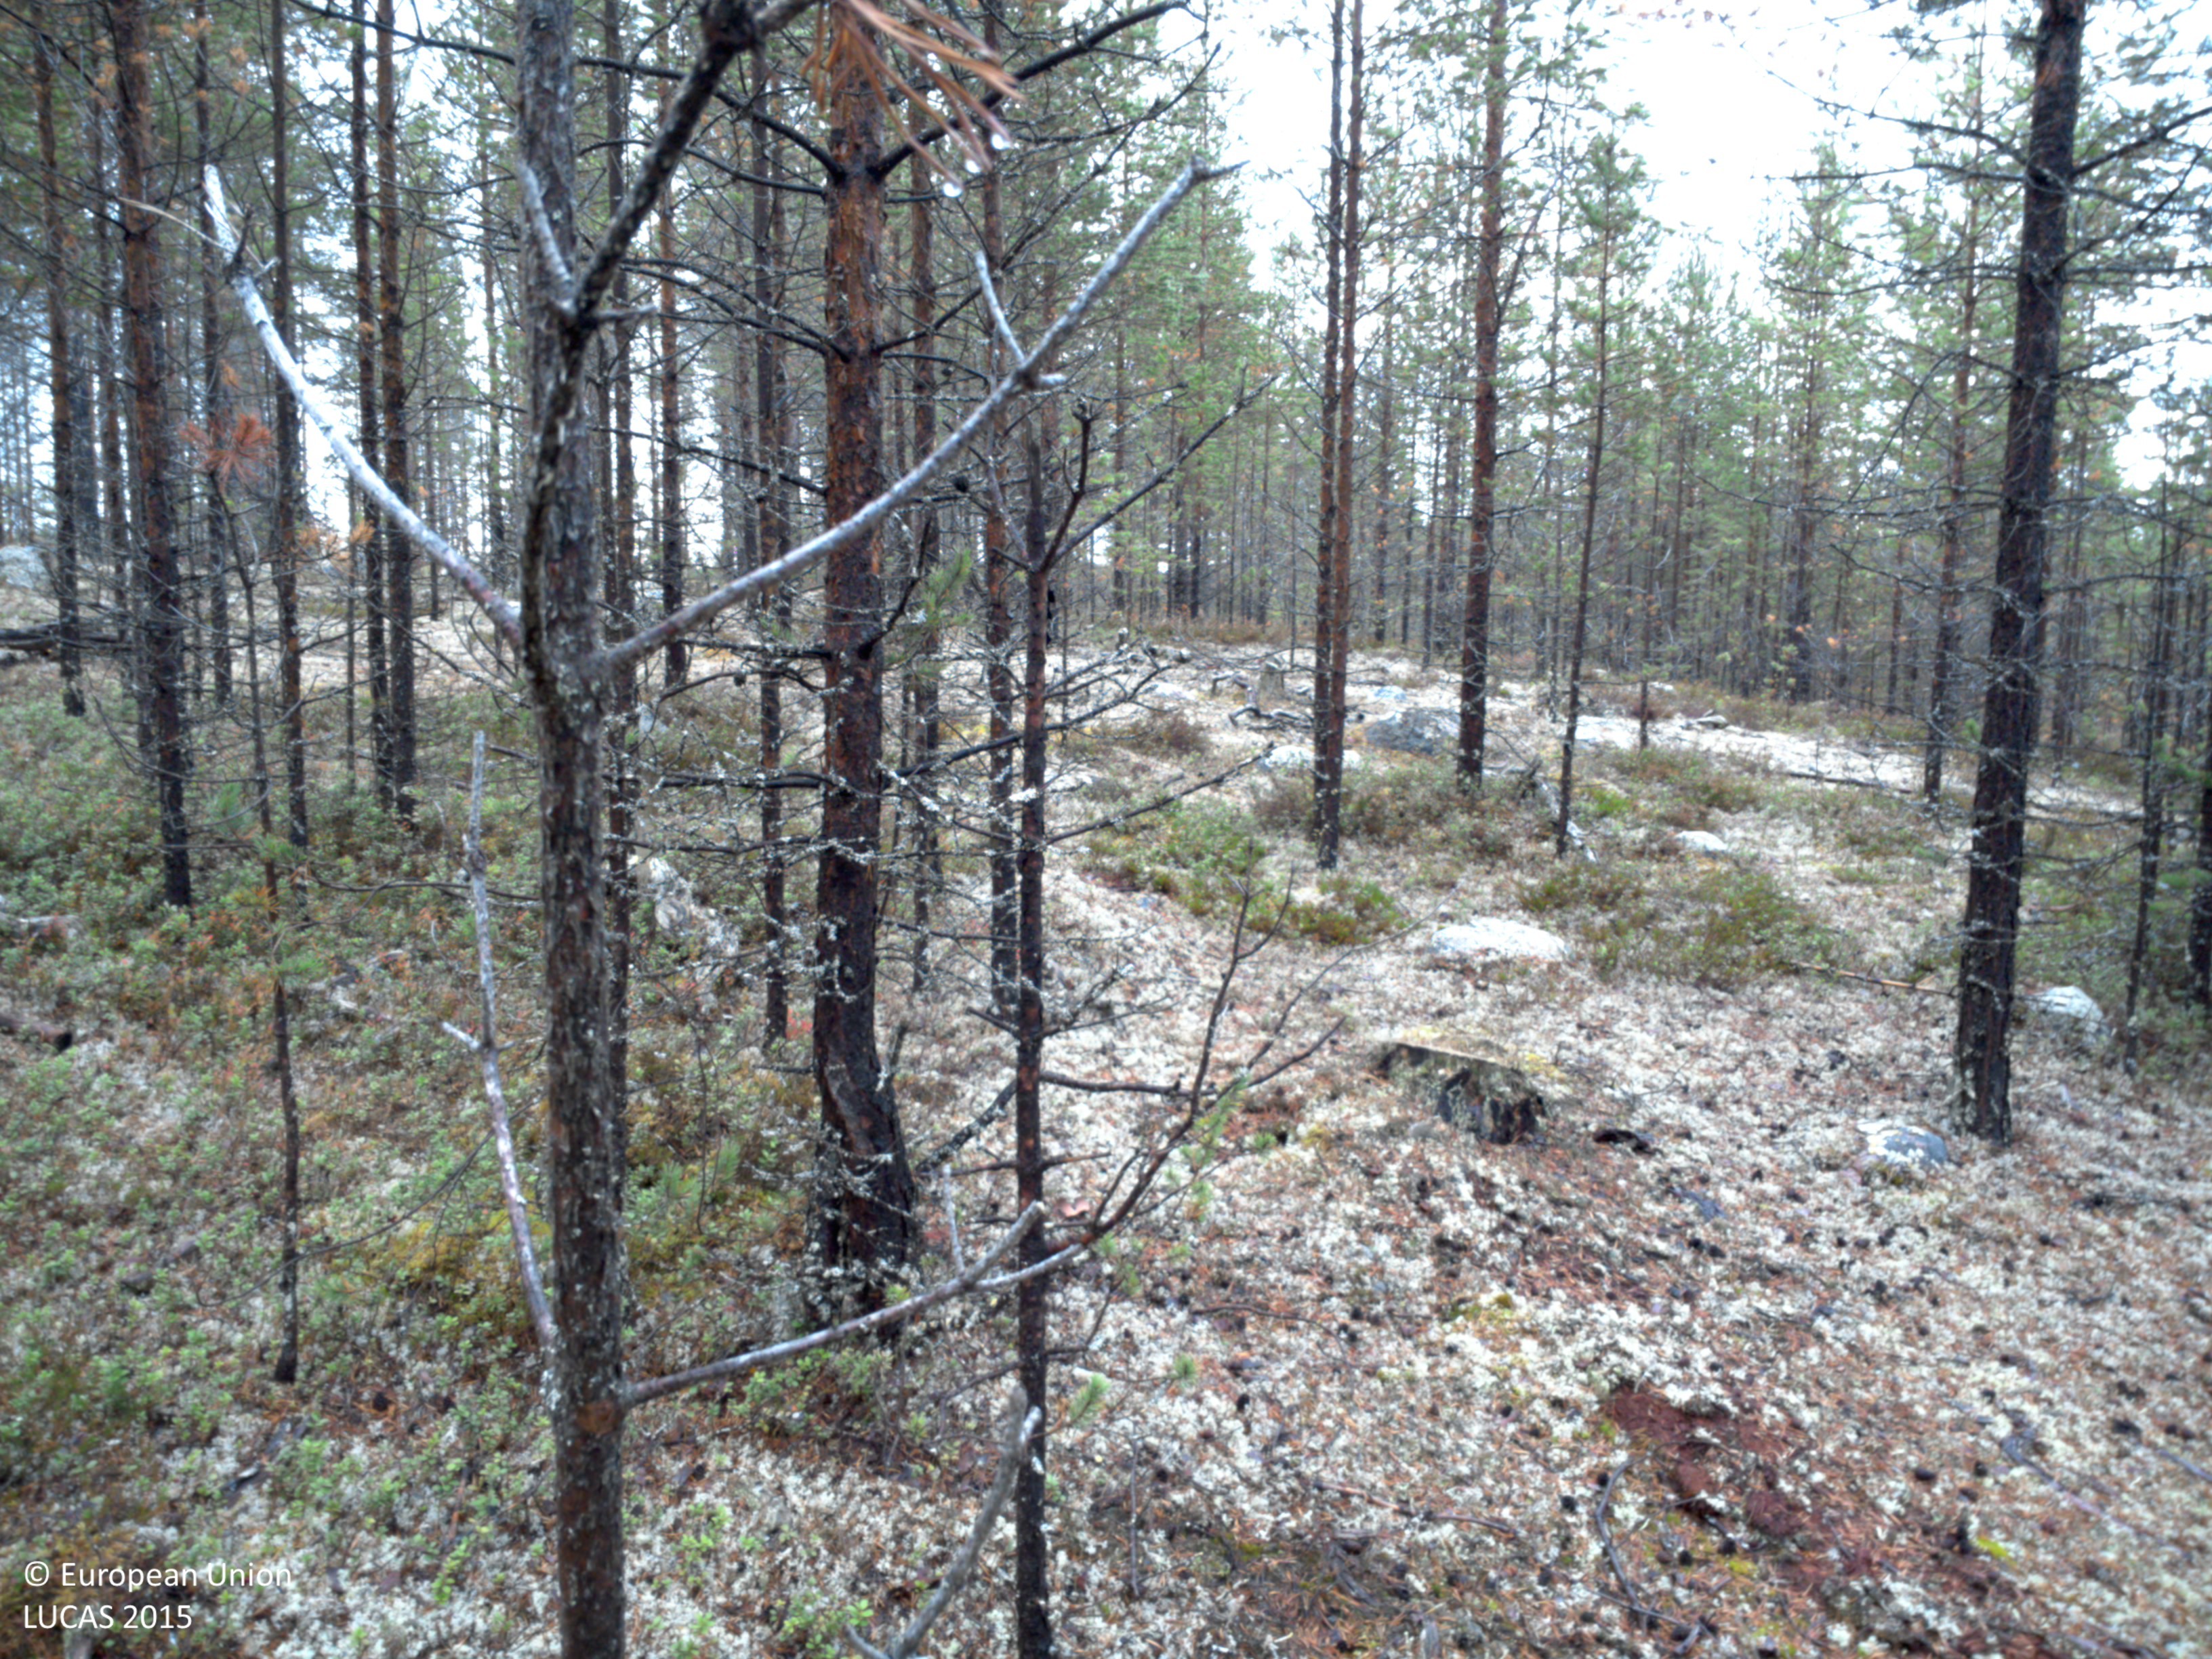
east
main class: Woodland
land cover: Pine dominated coniferous woodland
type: boreal forest
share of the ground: > 75 %
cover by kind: coniferous forest trees 80 %, shrubs 10 %, lichens and mosses 10 %
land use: Forestry
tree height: > 5 m
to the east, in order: Pine dominated coniferous woodland; Peatbogs; Pine dominated coniferous woodland; Peatbogs; Pine dominated coniferous woodland; Peatbogs
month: September
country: SE
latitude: 64.7323
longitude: 19.1860
